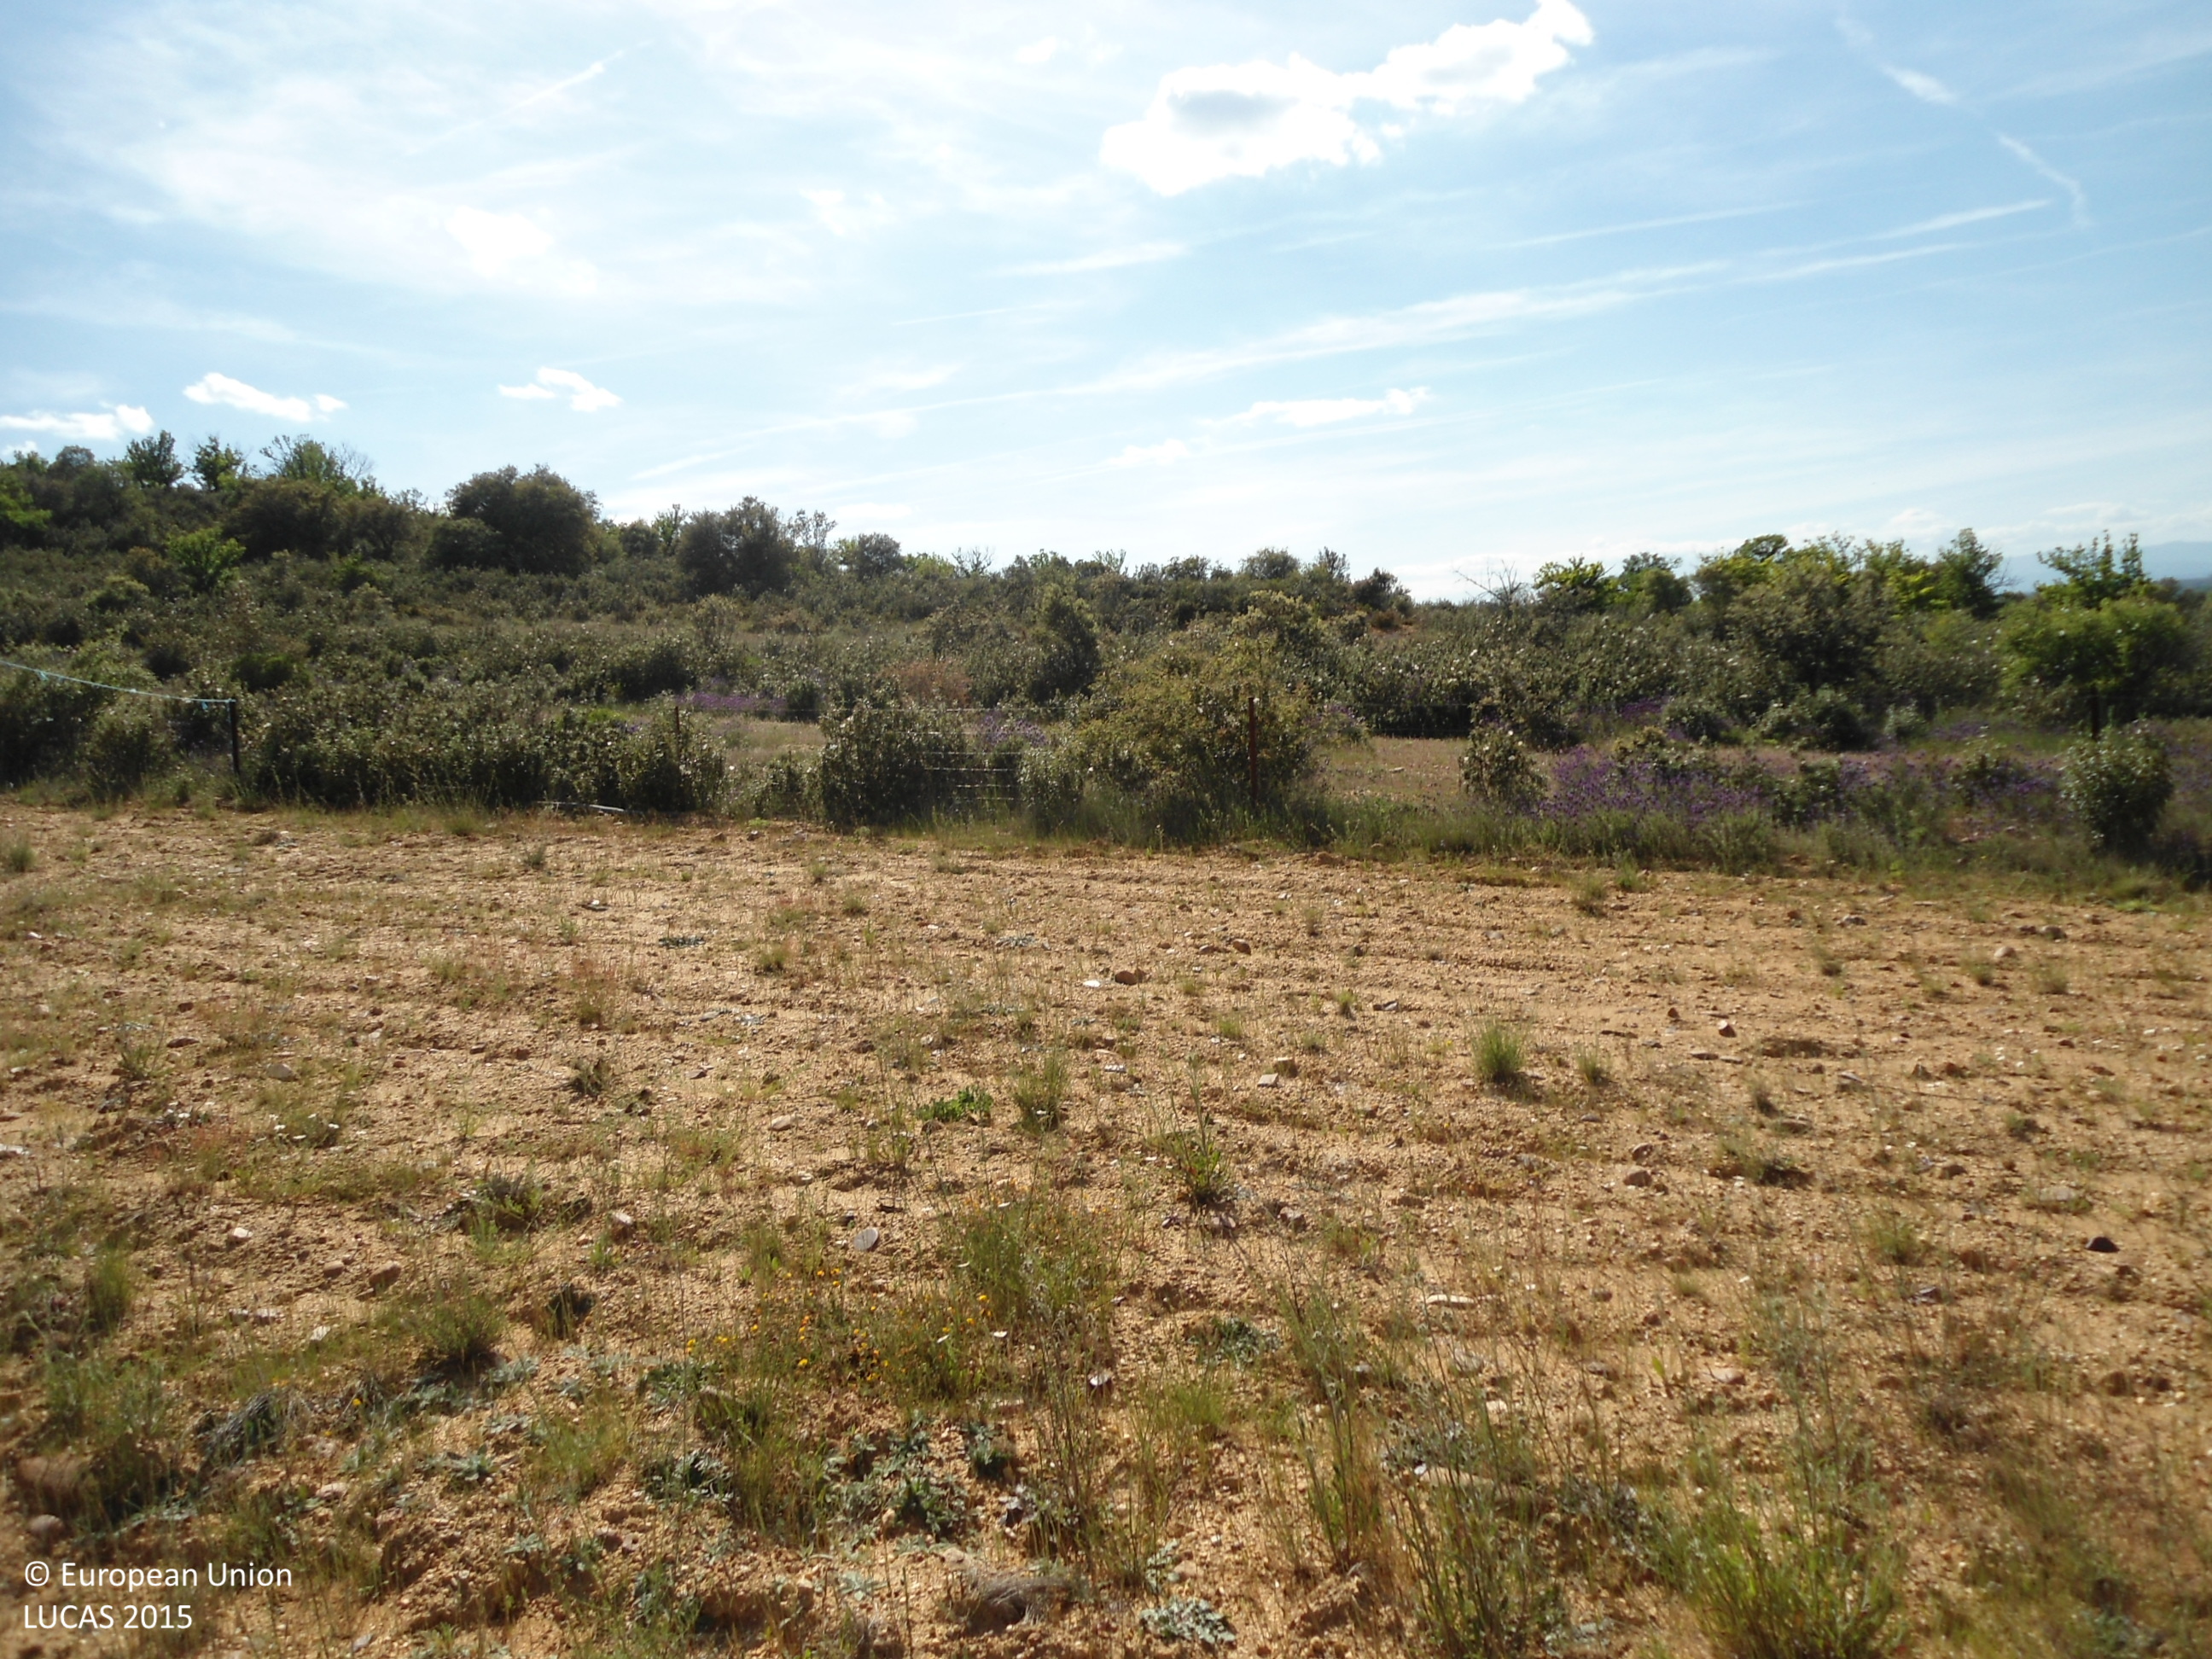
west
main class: Cropland
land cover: Nuts trees
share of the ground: < 10 %
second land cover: Other bare soil
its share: > 75 %
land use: Agriculture (excluding fallow land and kitchen gardens)
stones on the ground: < 10 %
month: May
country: ES
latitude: 41.9586
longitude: -6.0120
